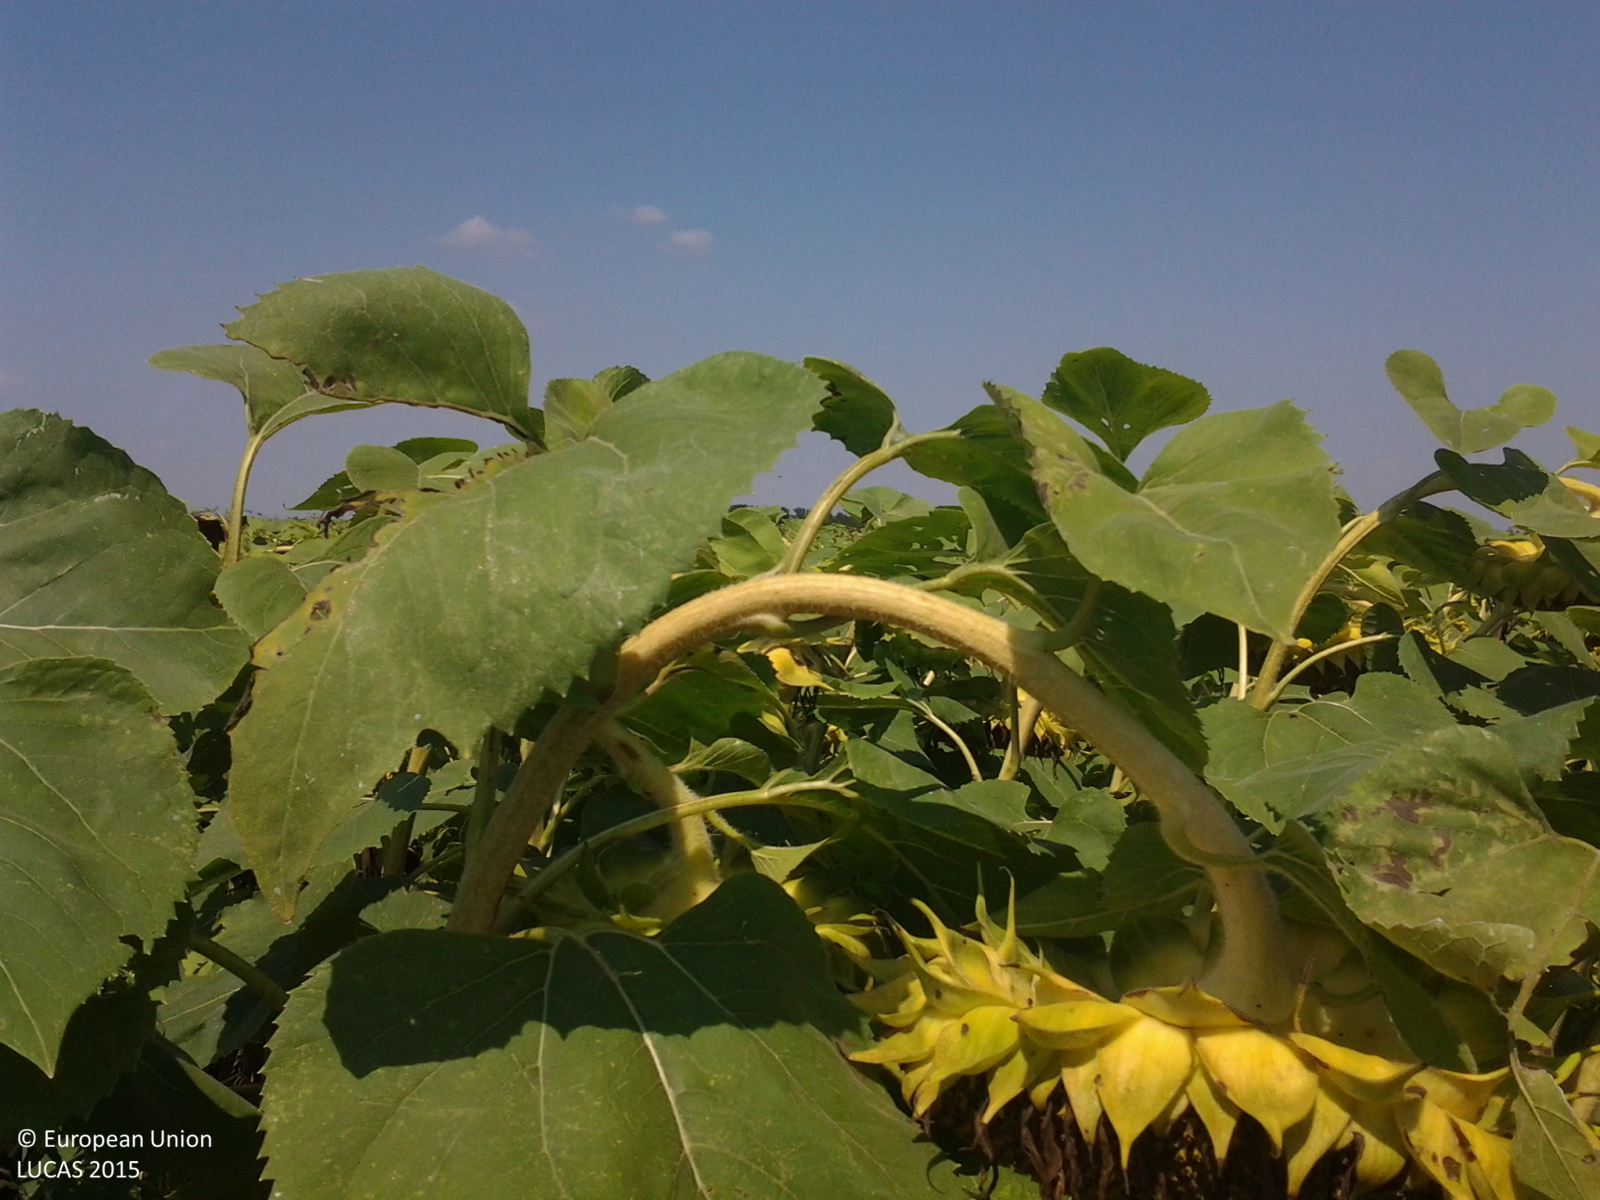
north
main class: Cropland
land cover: Sunflower
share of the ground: > 75 %
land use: Agriculture (excluding fallow land and kitchen gardens)
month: August
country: HU
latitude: 47.2386
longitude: 19.8384
